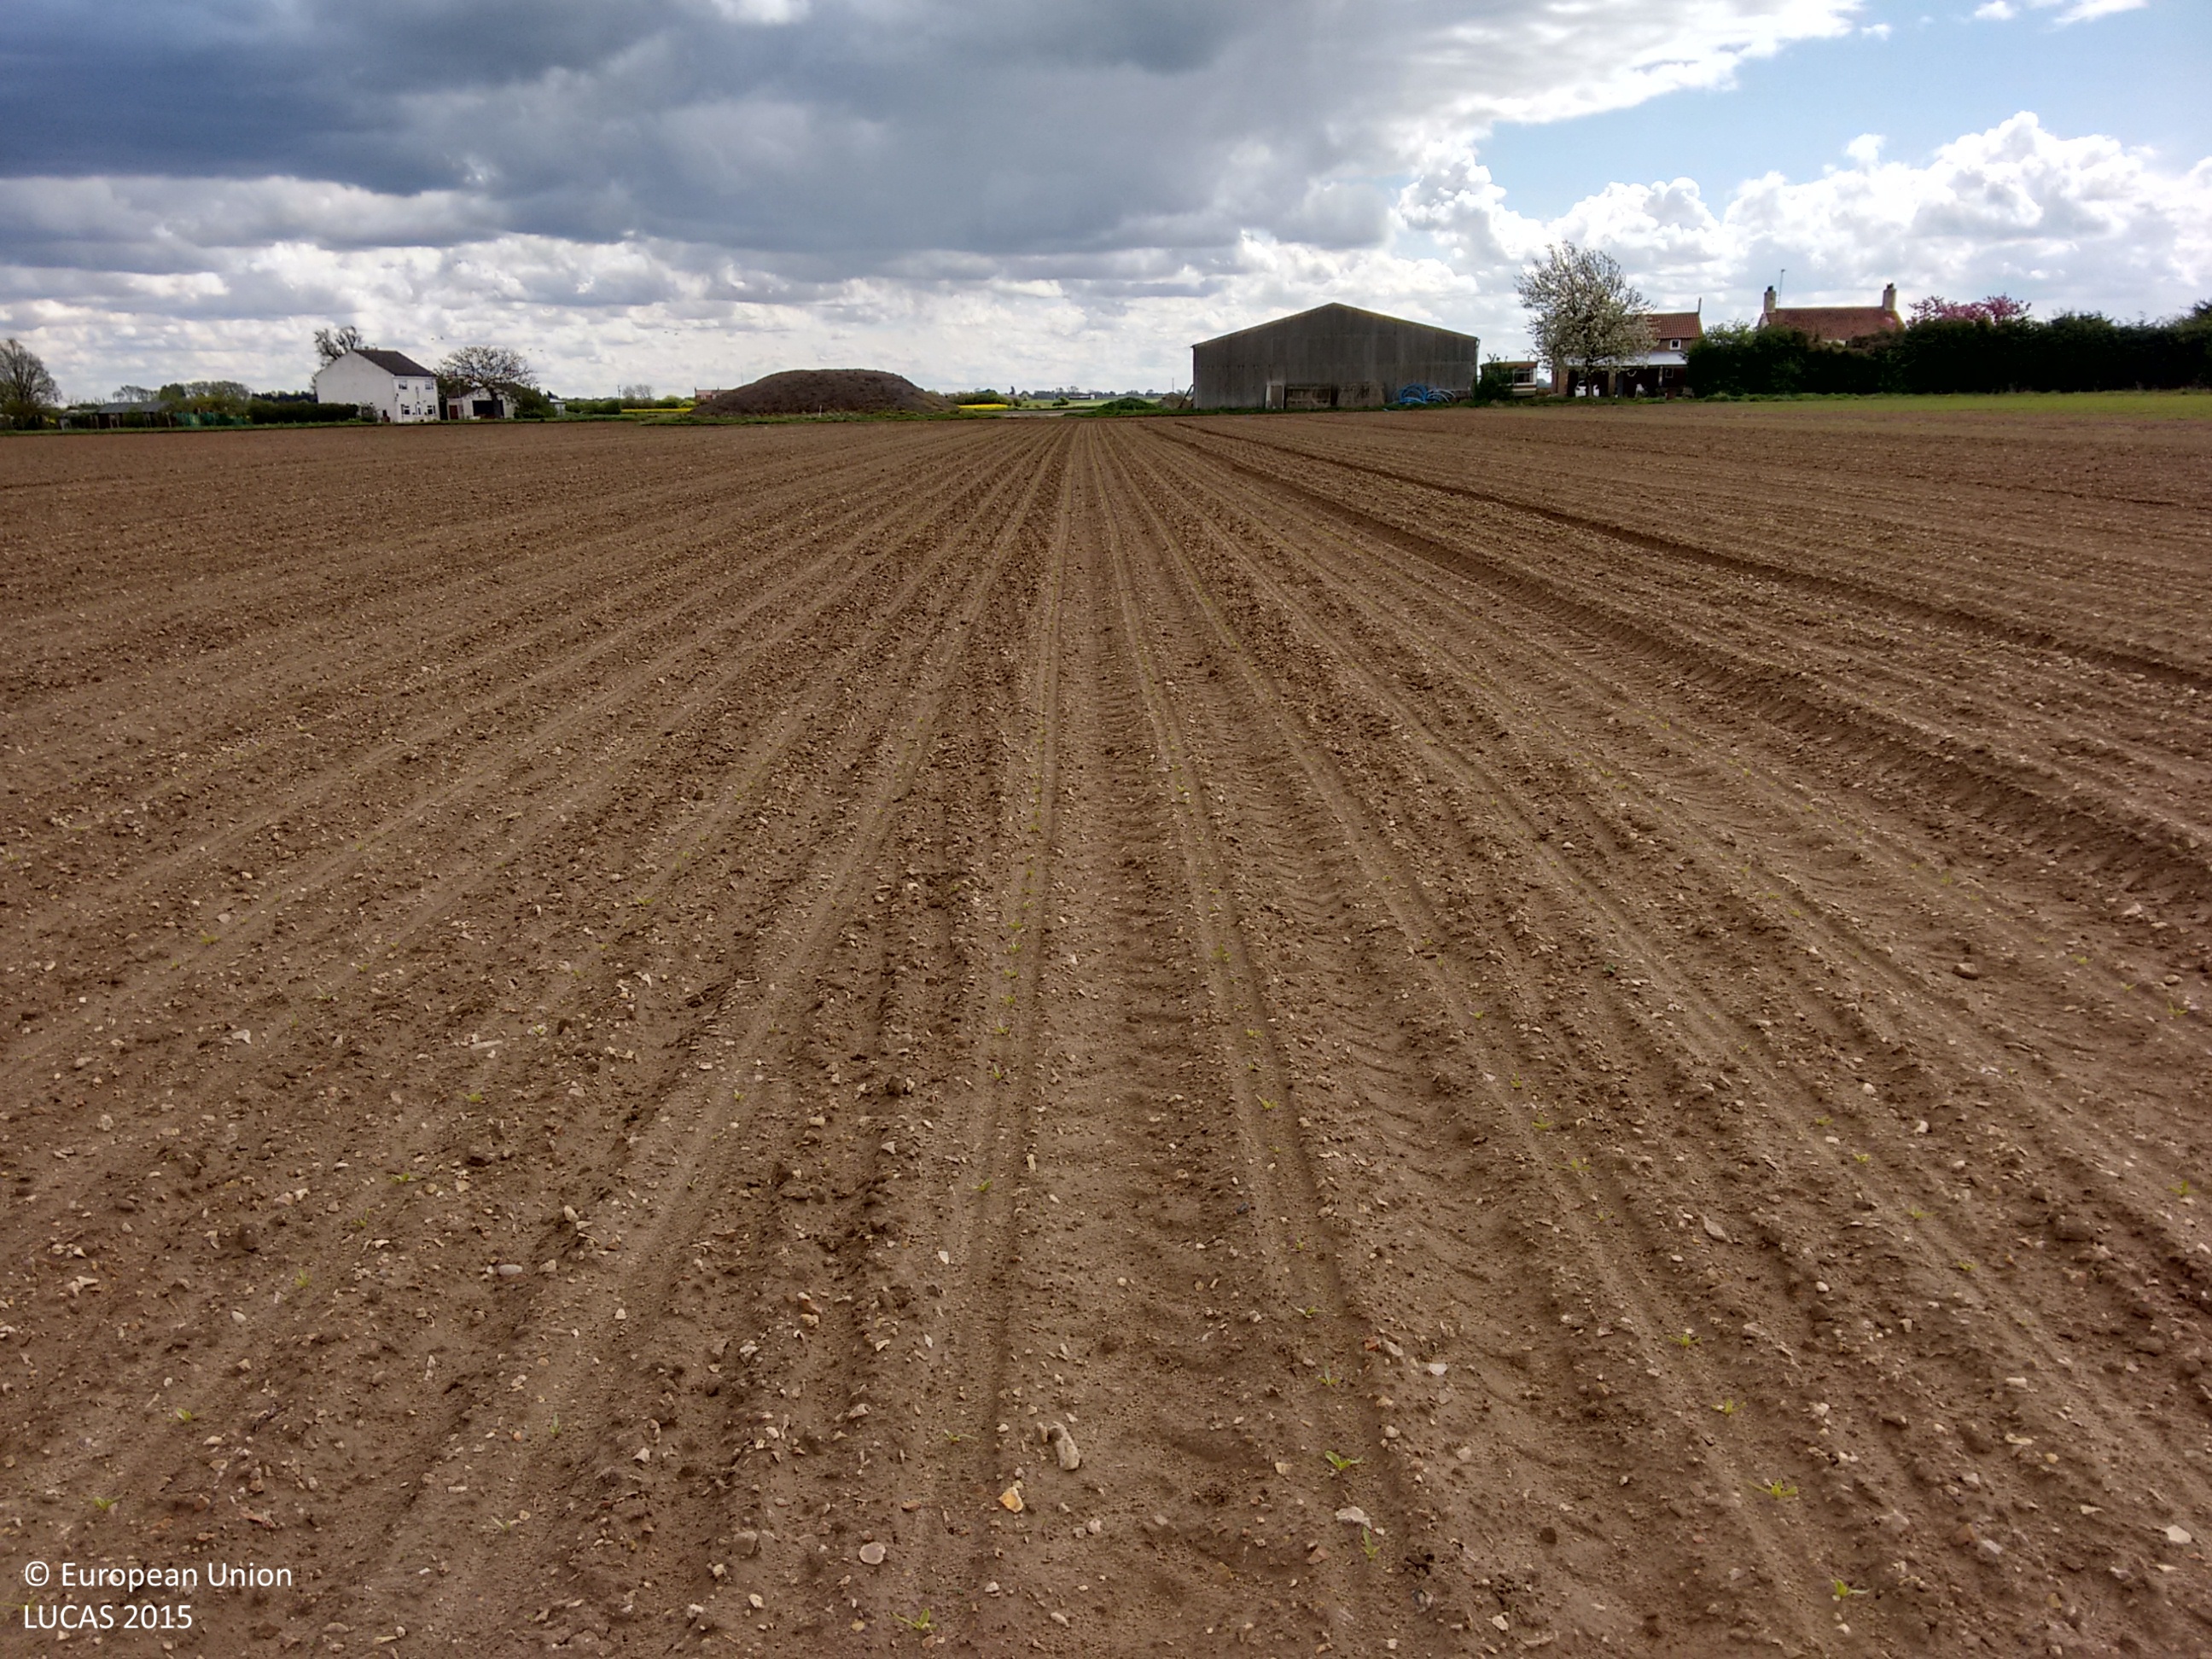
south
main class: Cropland
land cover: Other fresh vegetables
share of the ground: < 10 %
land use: Agriculture (excluding fallow land and kitchen gardens)
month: April
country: GB
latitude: 53.0814
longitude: -0.1705
